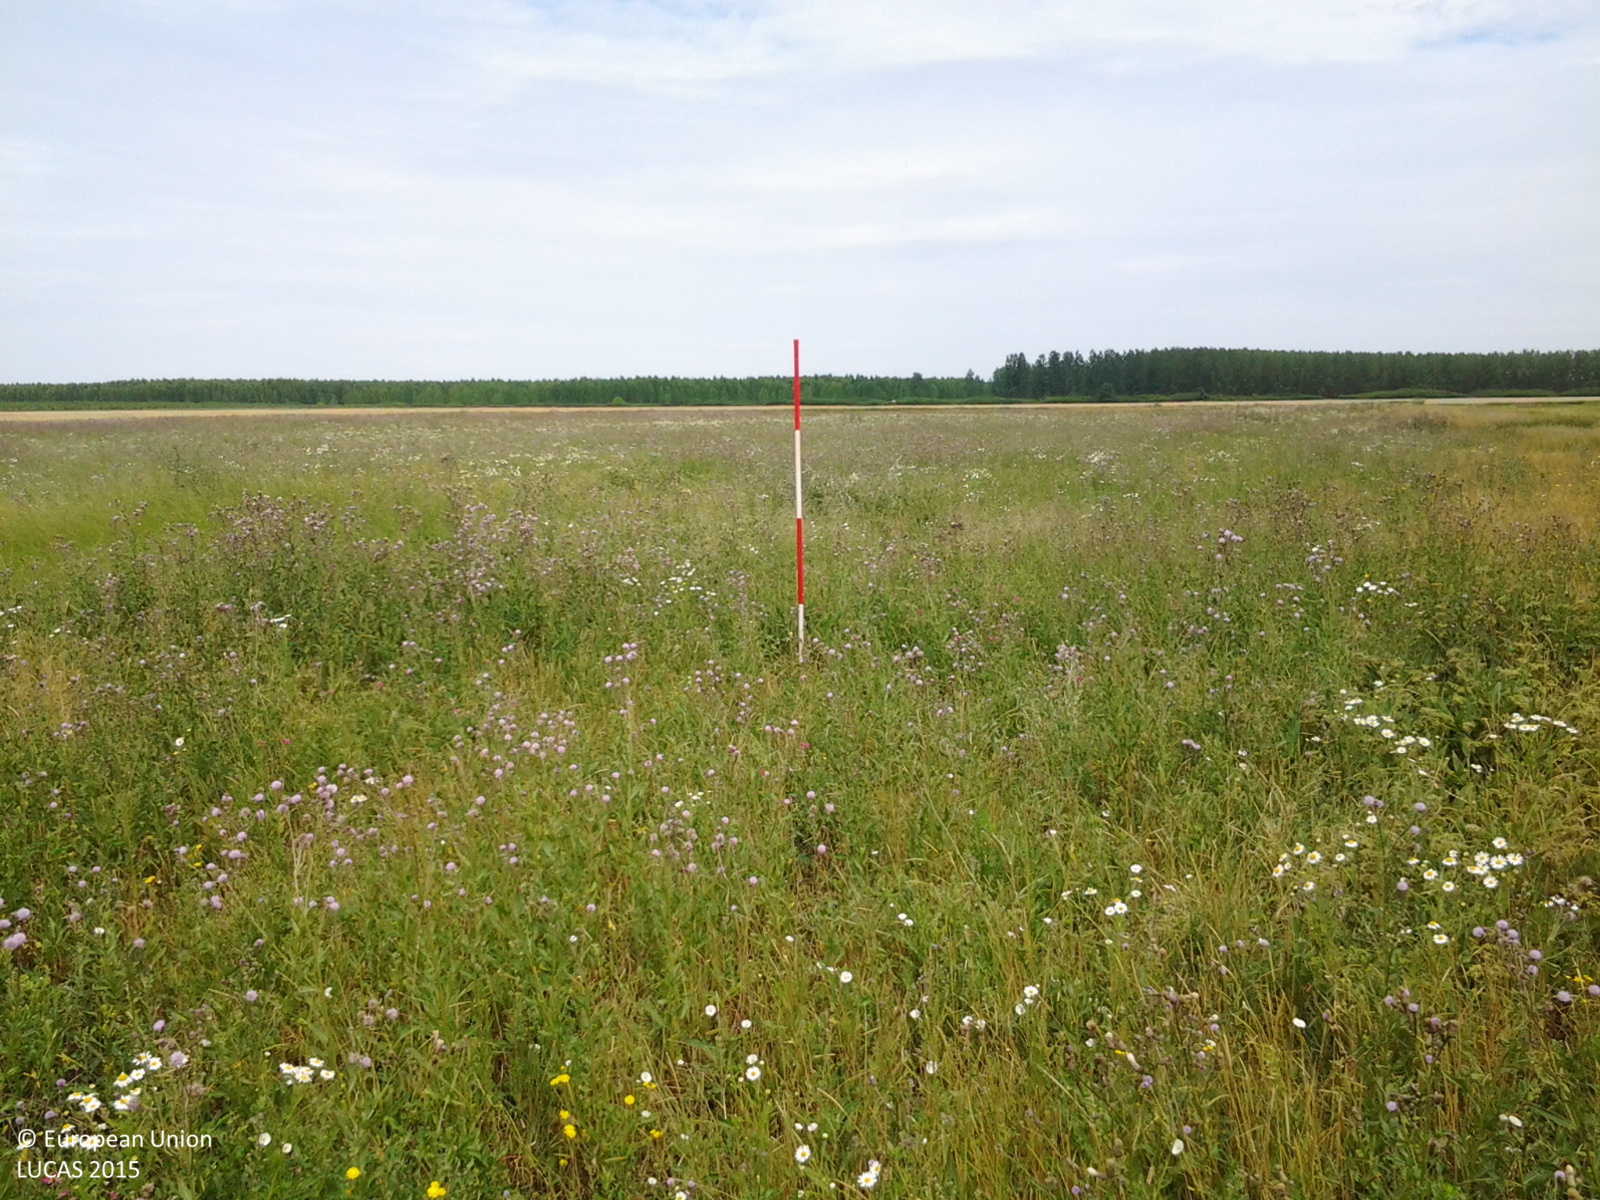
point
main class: Grassland
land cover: Grassland without tree/shrub cover
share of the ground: > 75 %
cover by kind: herbaceous plants 100 %
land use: Agriculture (excluding fallow land and kitchen gardens)
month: June
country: HU
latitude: 46.6317
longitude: 21.3878
